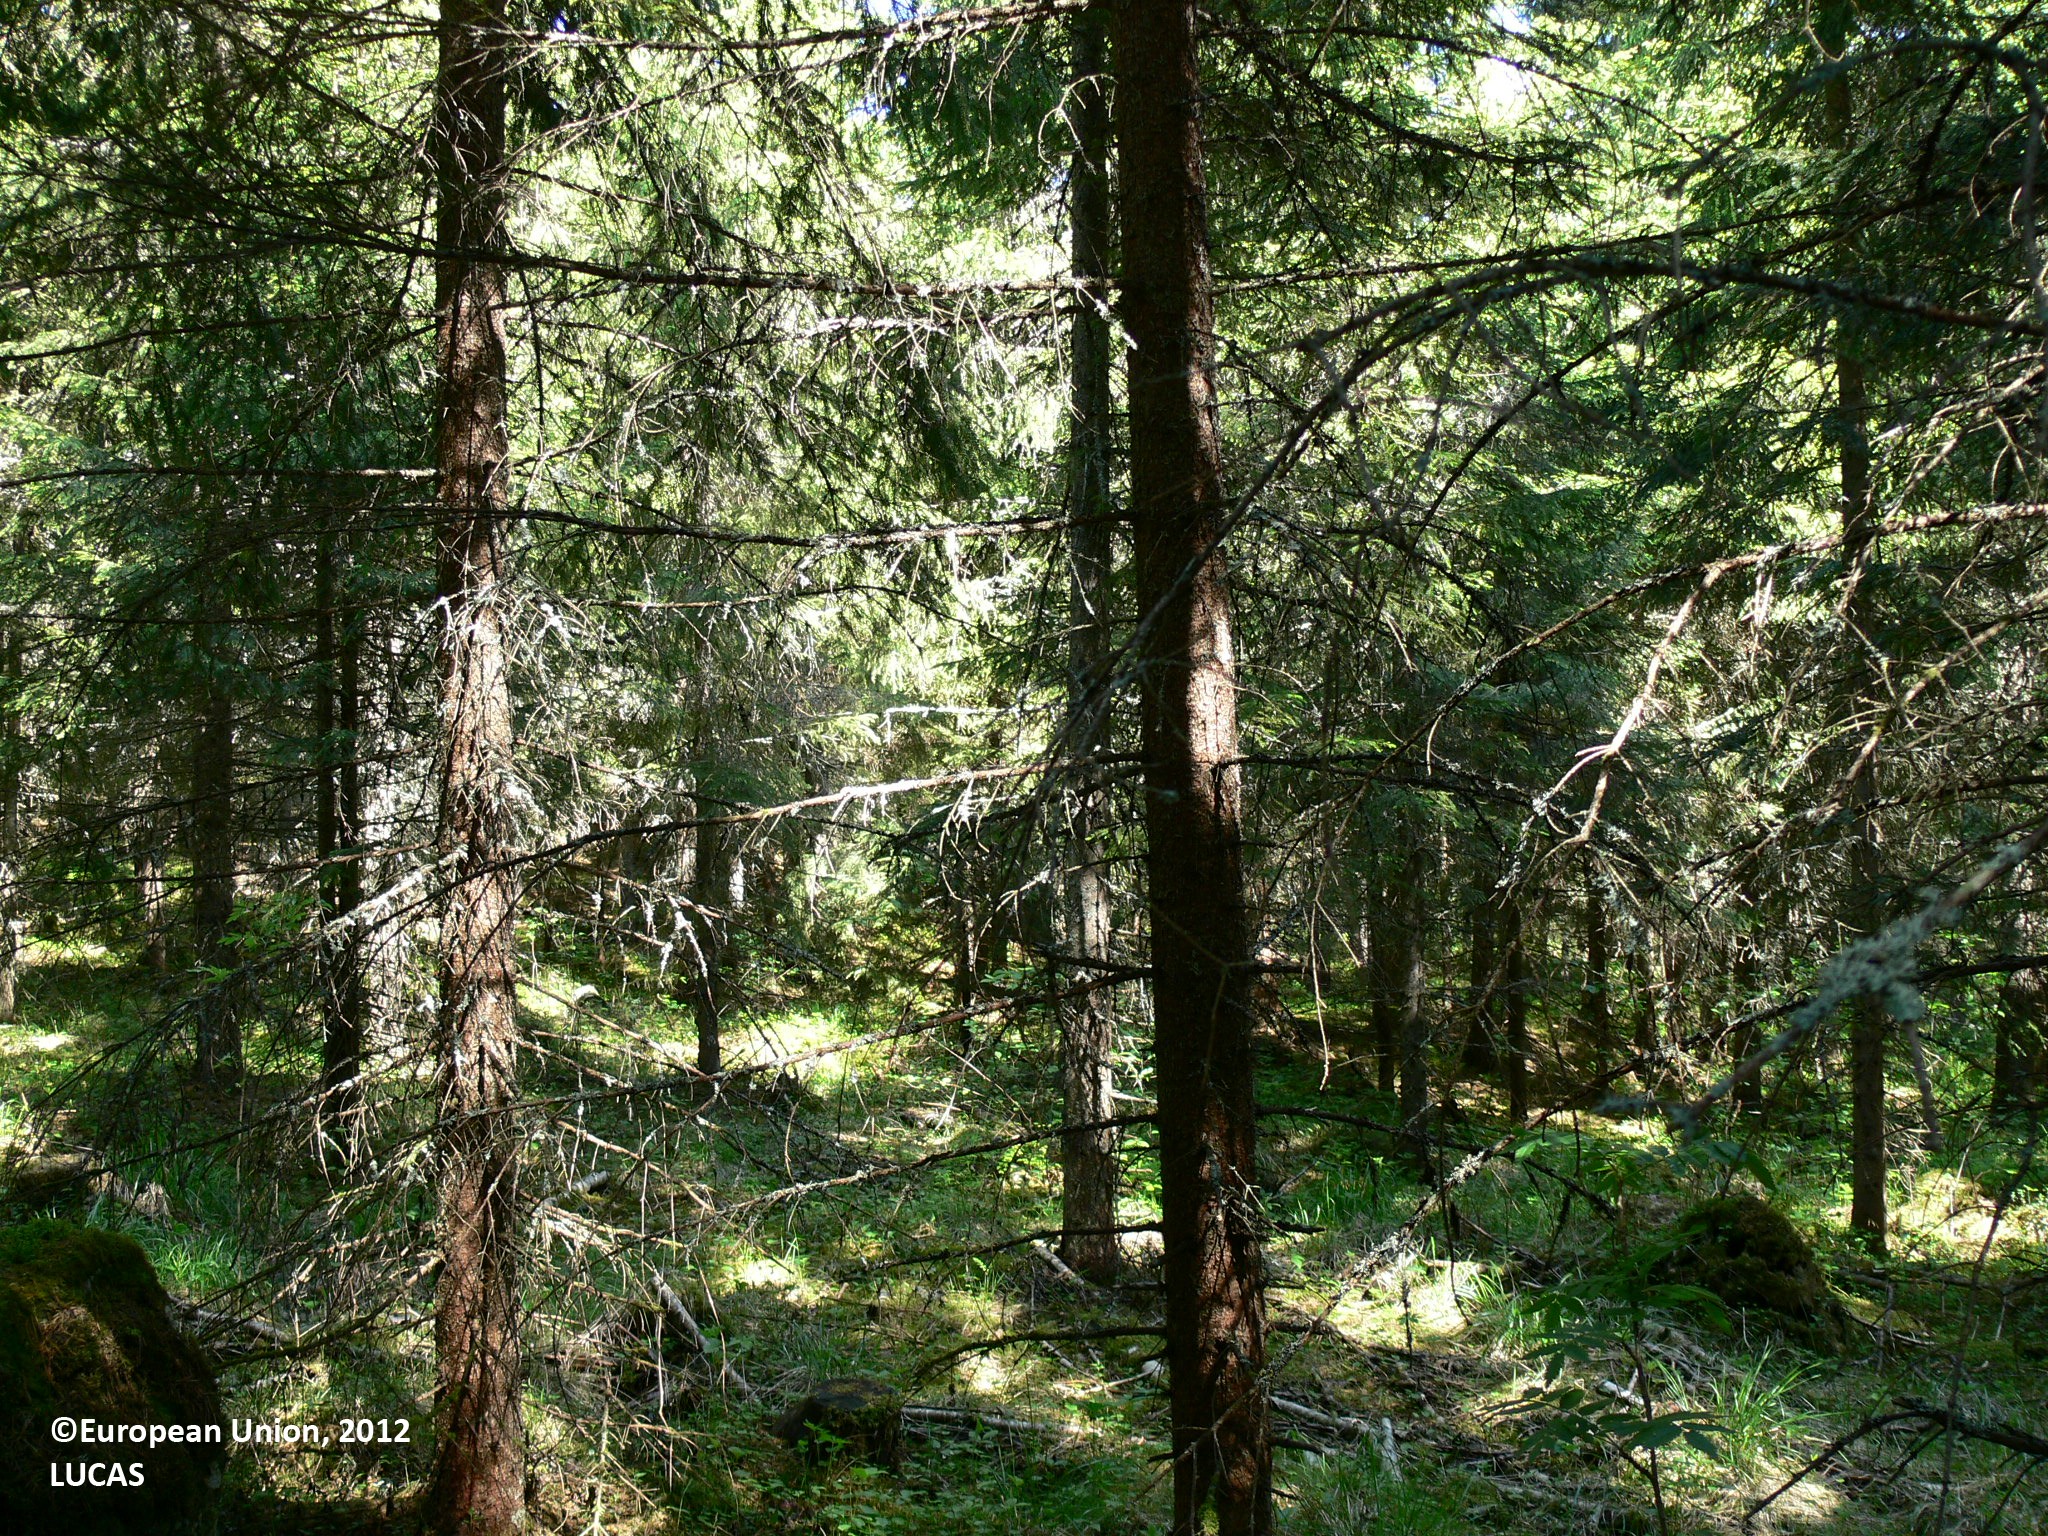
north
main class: Woodland
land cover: Spruce dominated coniferous woodland
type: boreal forest
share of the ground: > 75 %
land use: Forestry
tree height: > 5 m
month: June
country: FI
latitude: 62.5798
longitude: 30.3832
